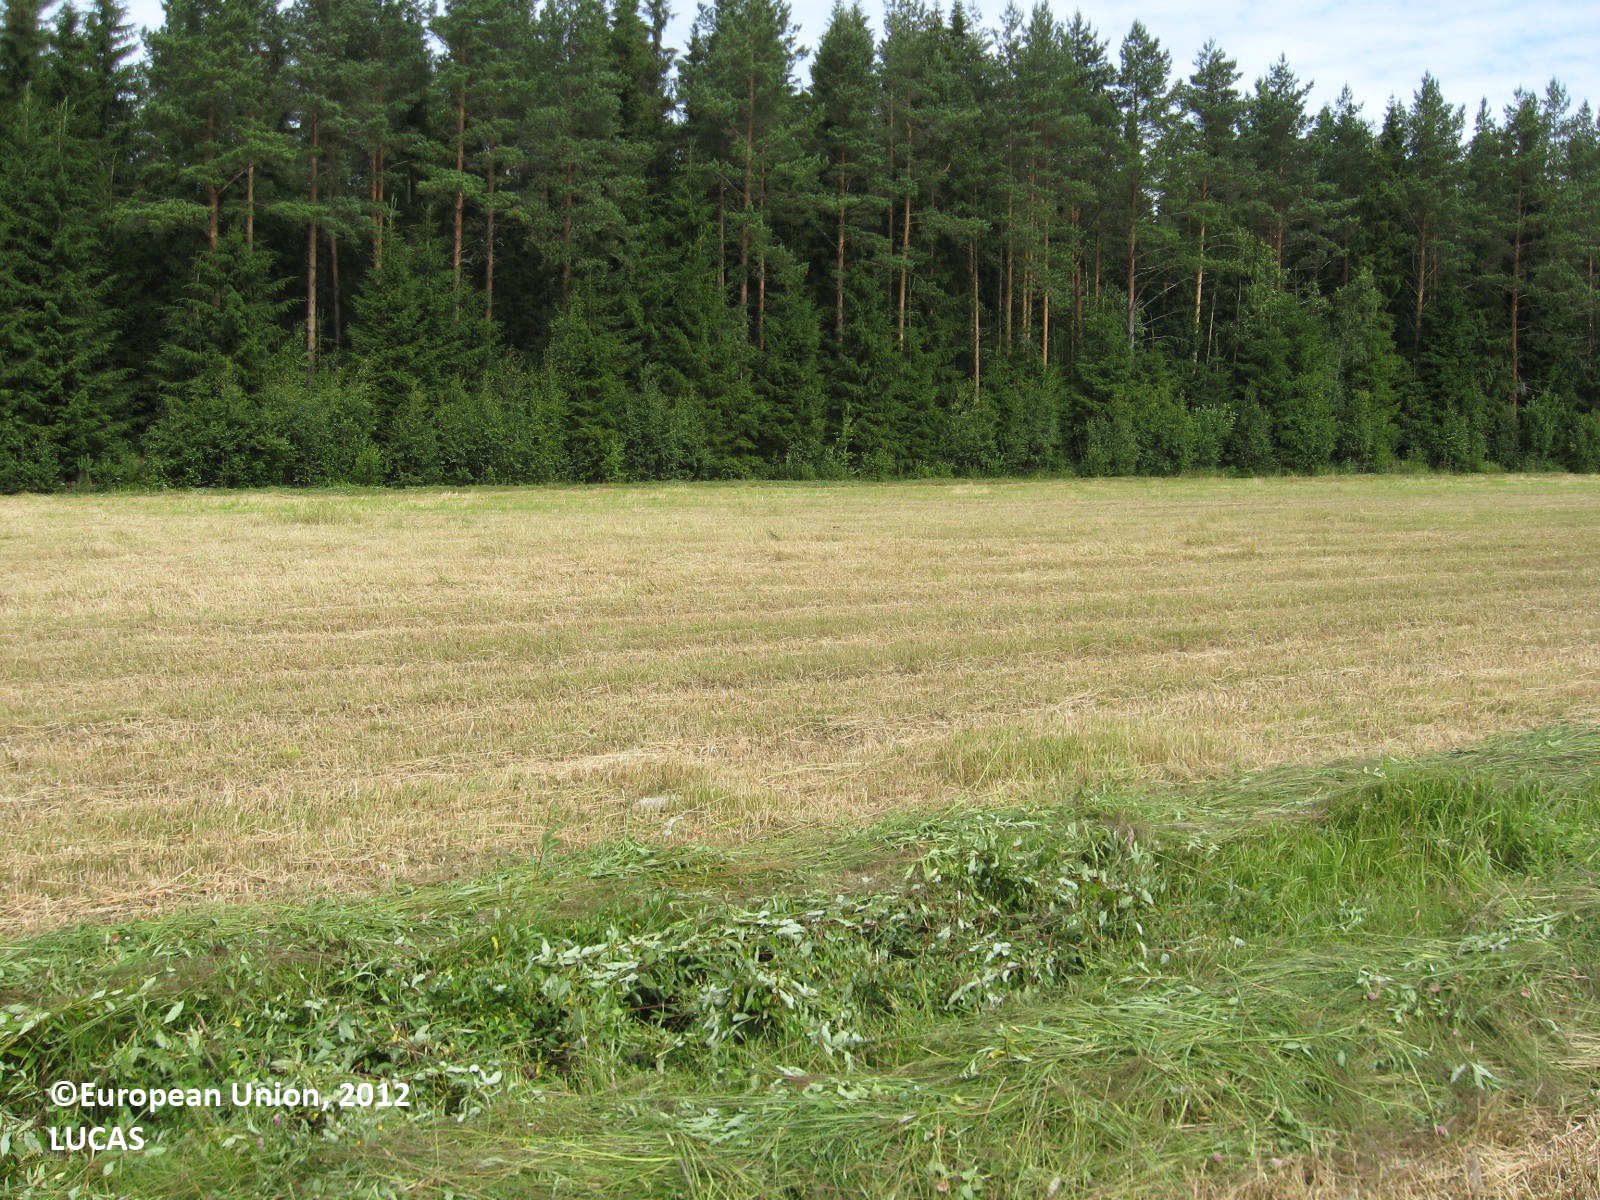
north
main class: Cropland
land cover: Temporary grasslands
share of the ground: > 75 %
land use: Agriculture (excluding fallow land and kitchen gardens)
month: July
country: FI
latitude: 61.9864
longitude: 21.5175
